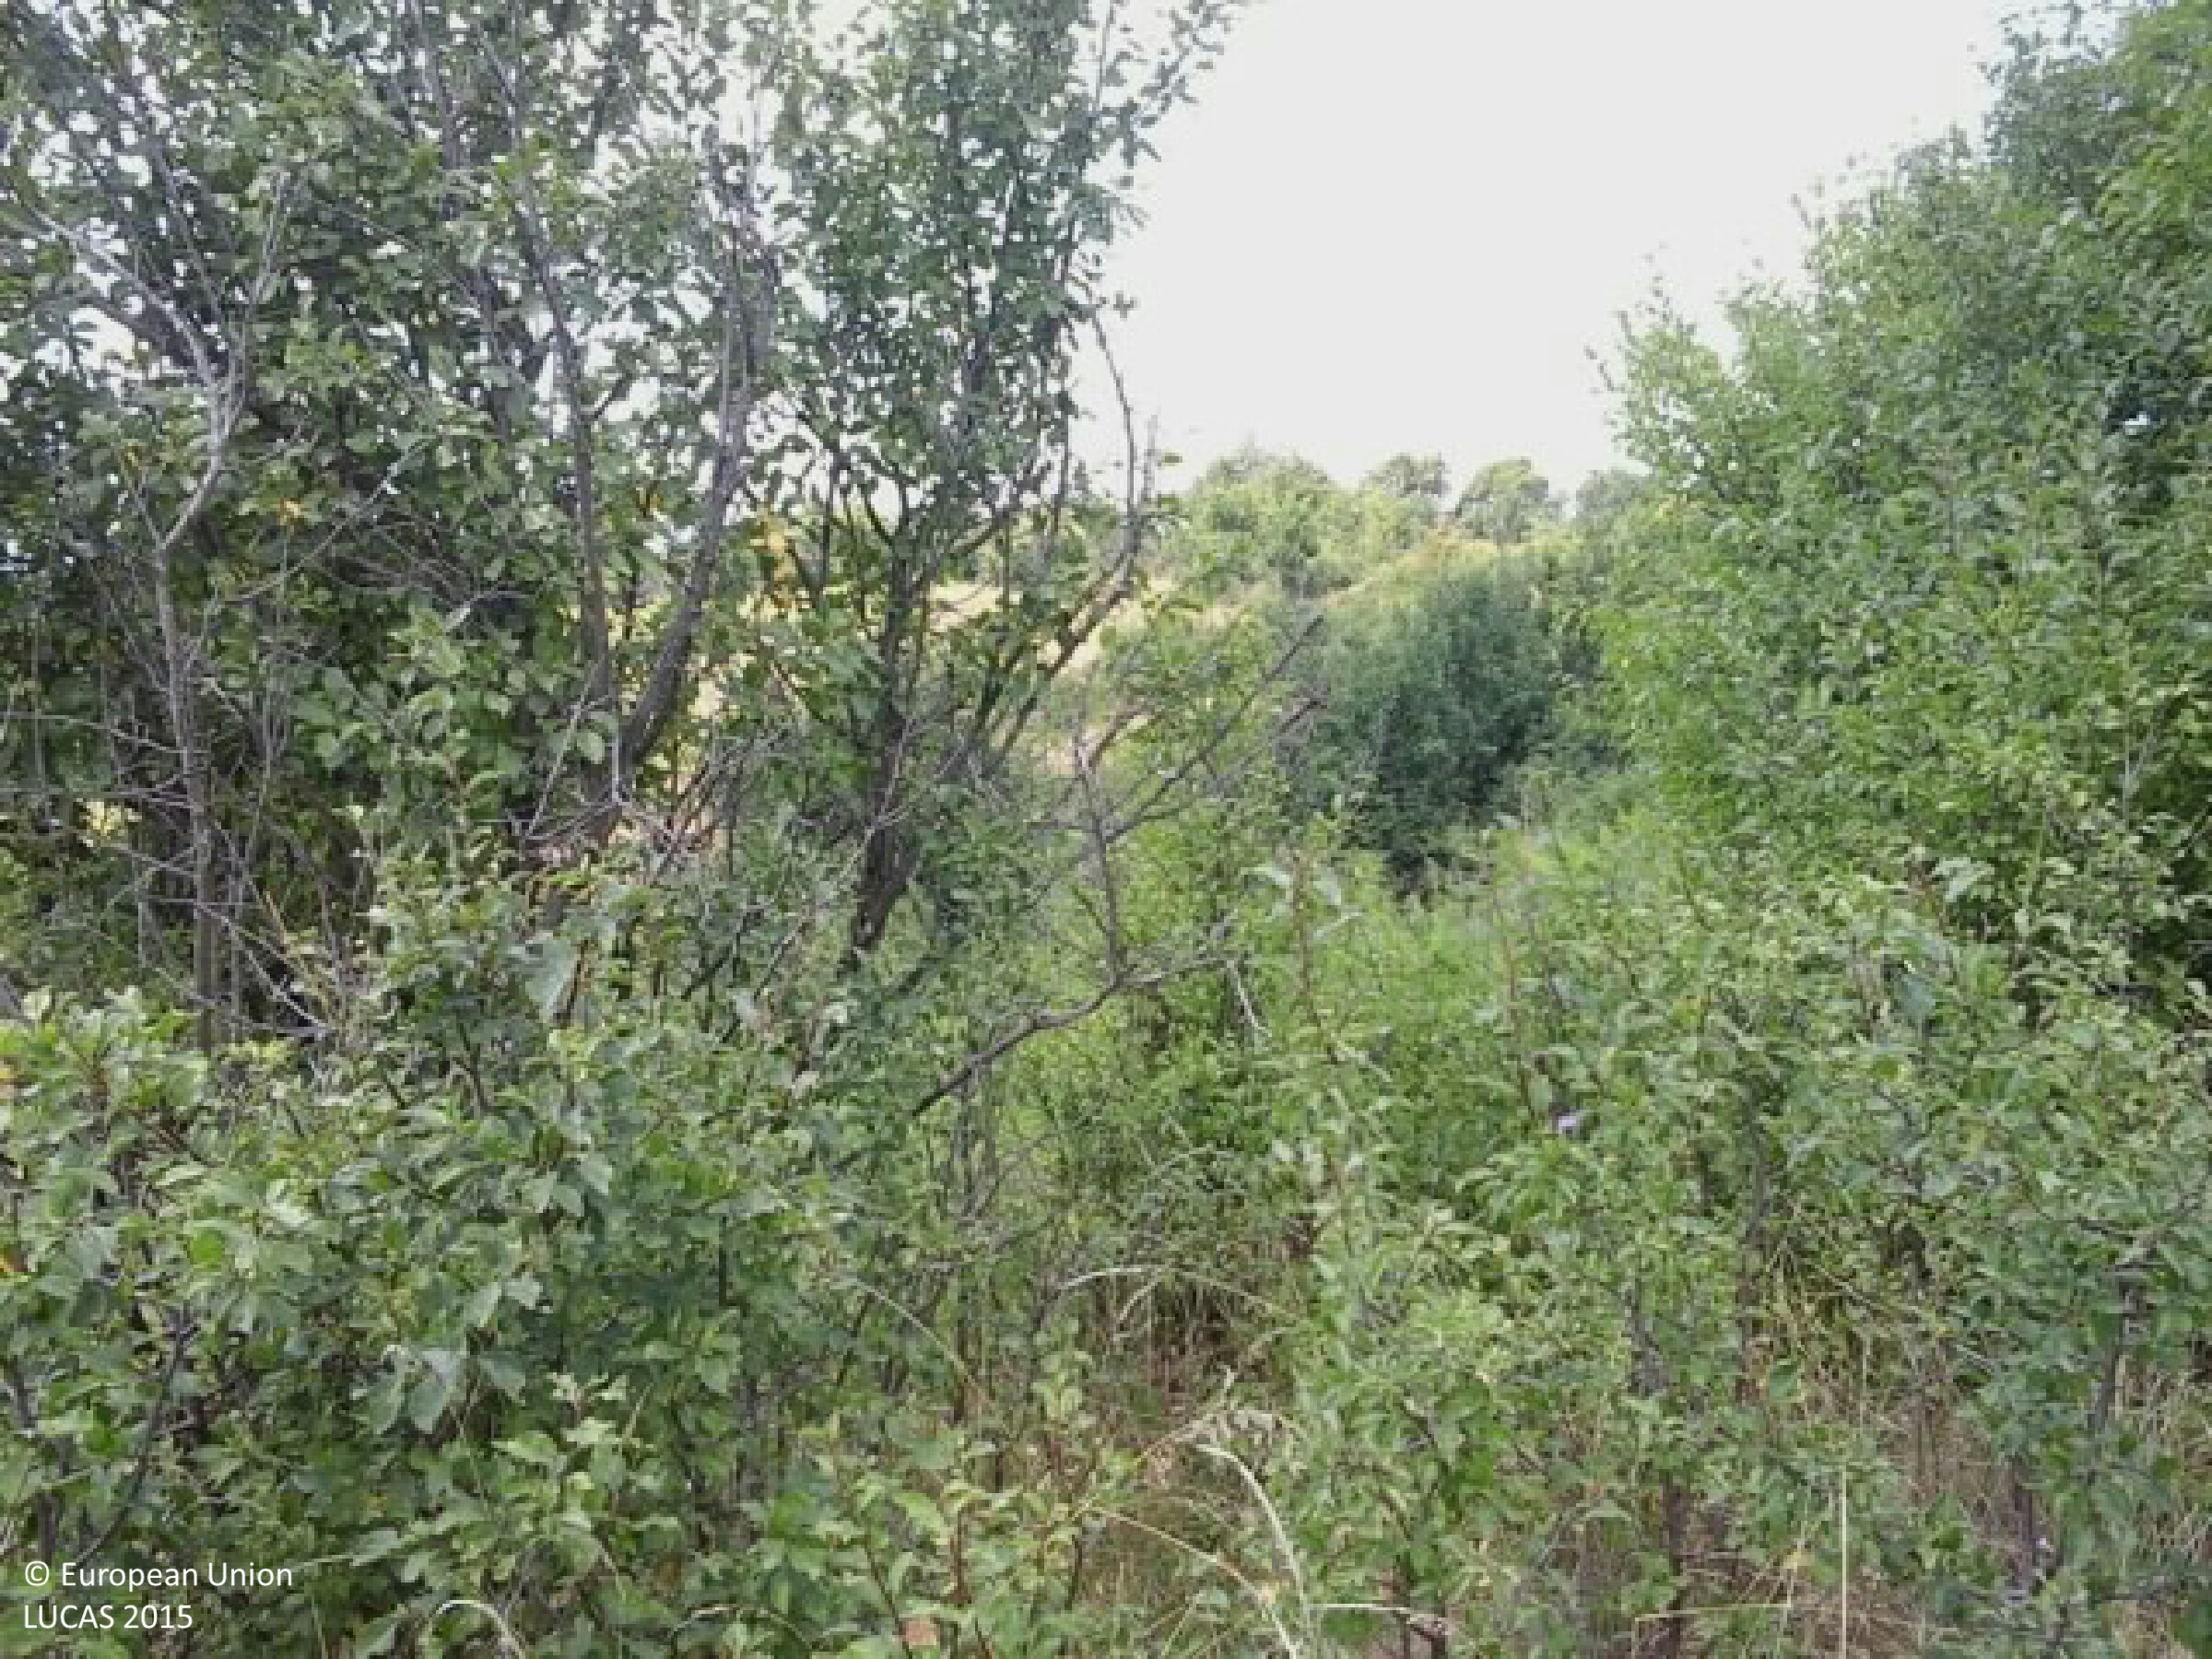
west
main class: Grassland
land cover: Grassland with sparse tree/shrub cover
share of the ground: > 75 %
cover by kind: herbaceous plants 90 %, broadleaved forest trees 5 %, shrubs 5 %
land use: Abandoned areas
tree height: < 5 m
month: July
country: HU
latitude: 48.3279
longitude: 20.7876
